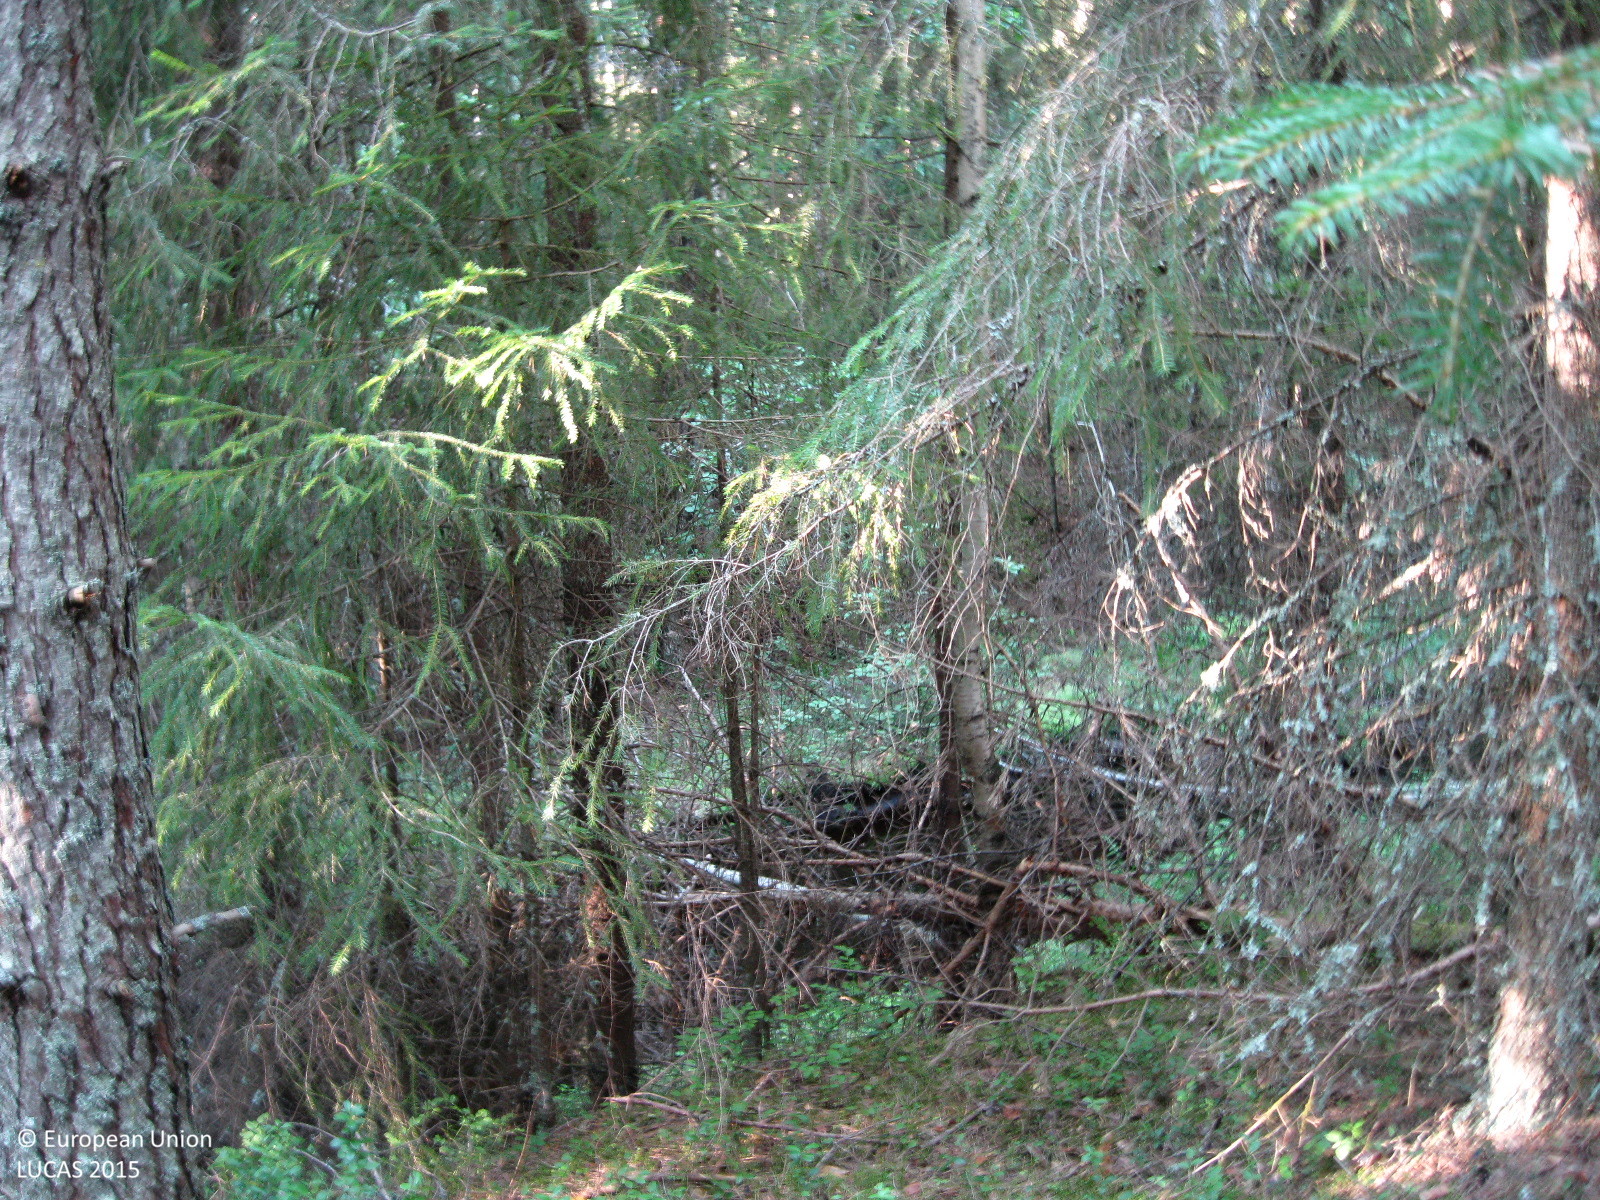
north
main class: Woodland
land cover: Pine dominated mixed woodland
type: boreal forest
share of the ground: > 75 %
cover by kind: coniferous forest trees 65 %, broadleaved forest trees 25 %, shrubs 5 %, herbaceous plants 5 %
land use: Forestry
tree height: > 5 m
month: August
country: FI
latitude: 61.2903
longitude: 25.2895
